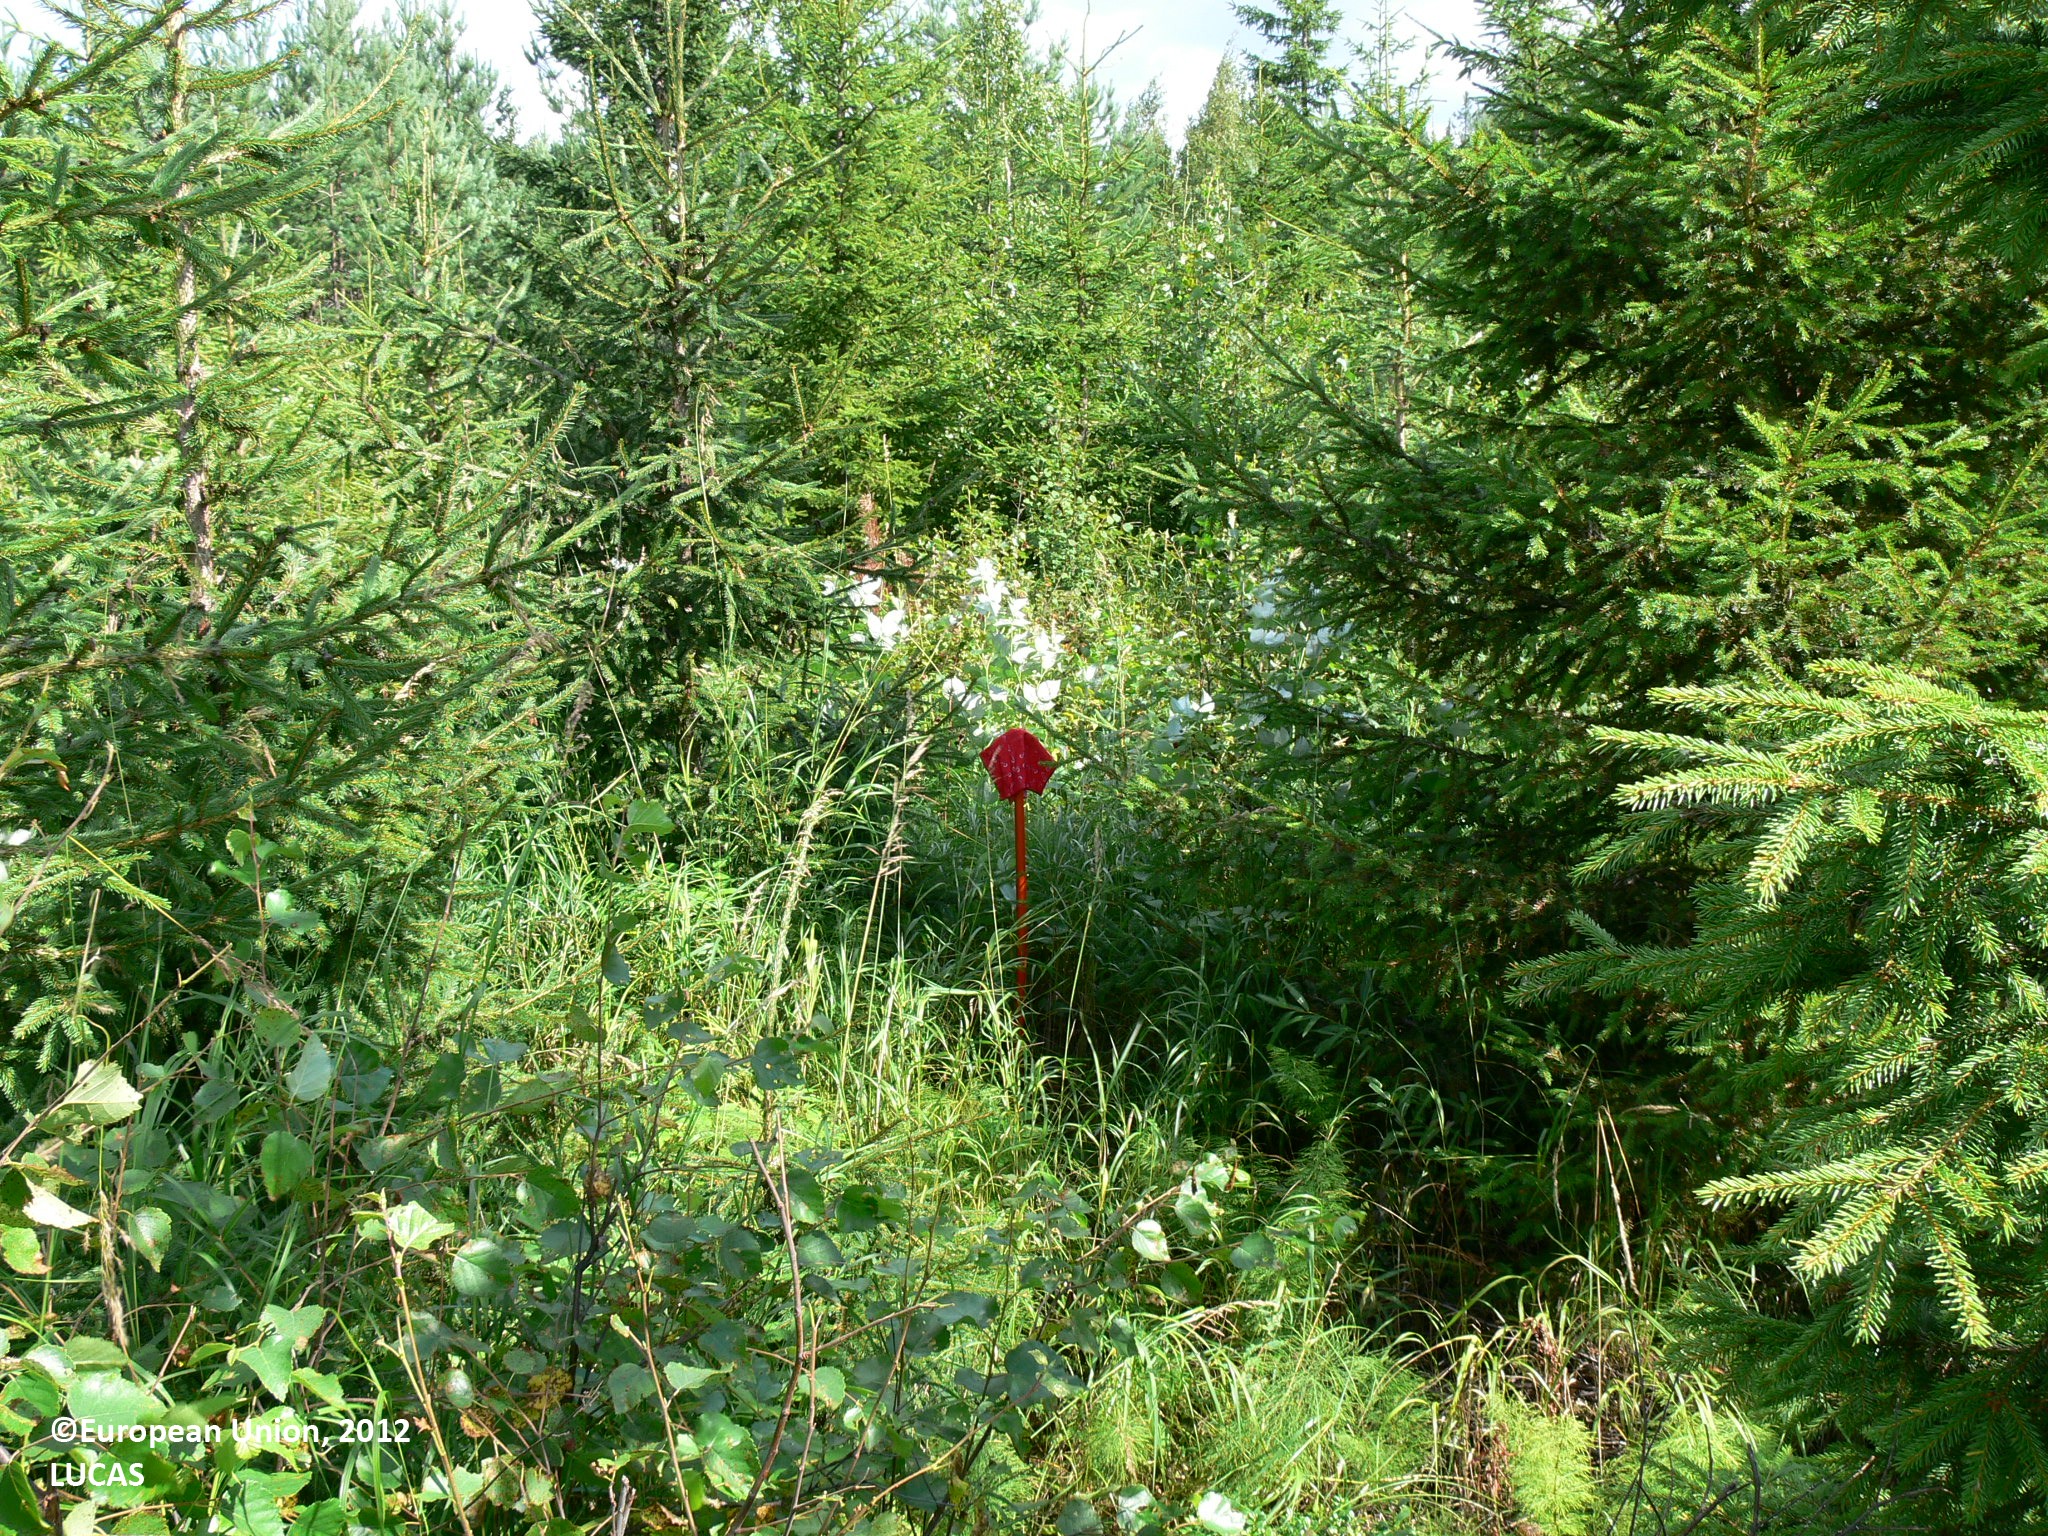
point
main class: Woodland
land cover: Spruce dominated mixed woodland
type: boreal forest
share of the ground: 50 - 75 %
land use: Forestry
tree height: < 5 m
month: August
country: FI
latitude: 61.9608
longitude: 29.2873
